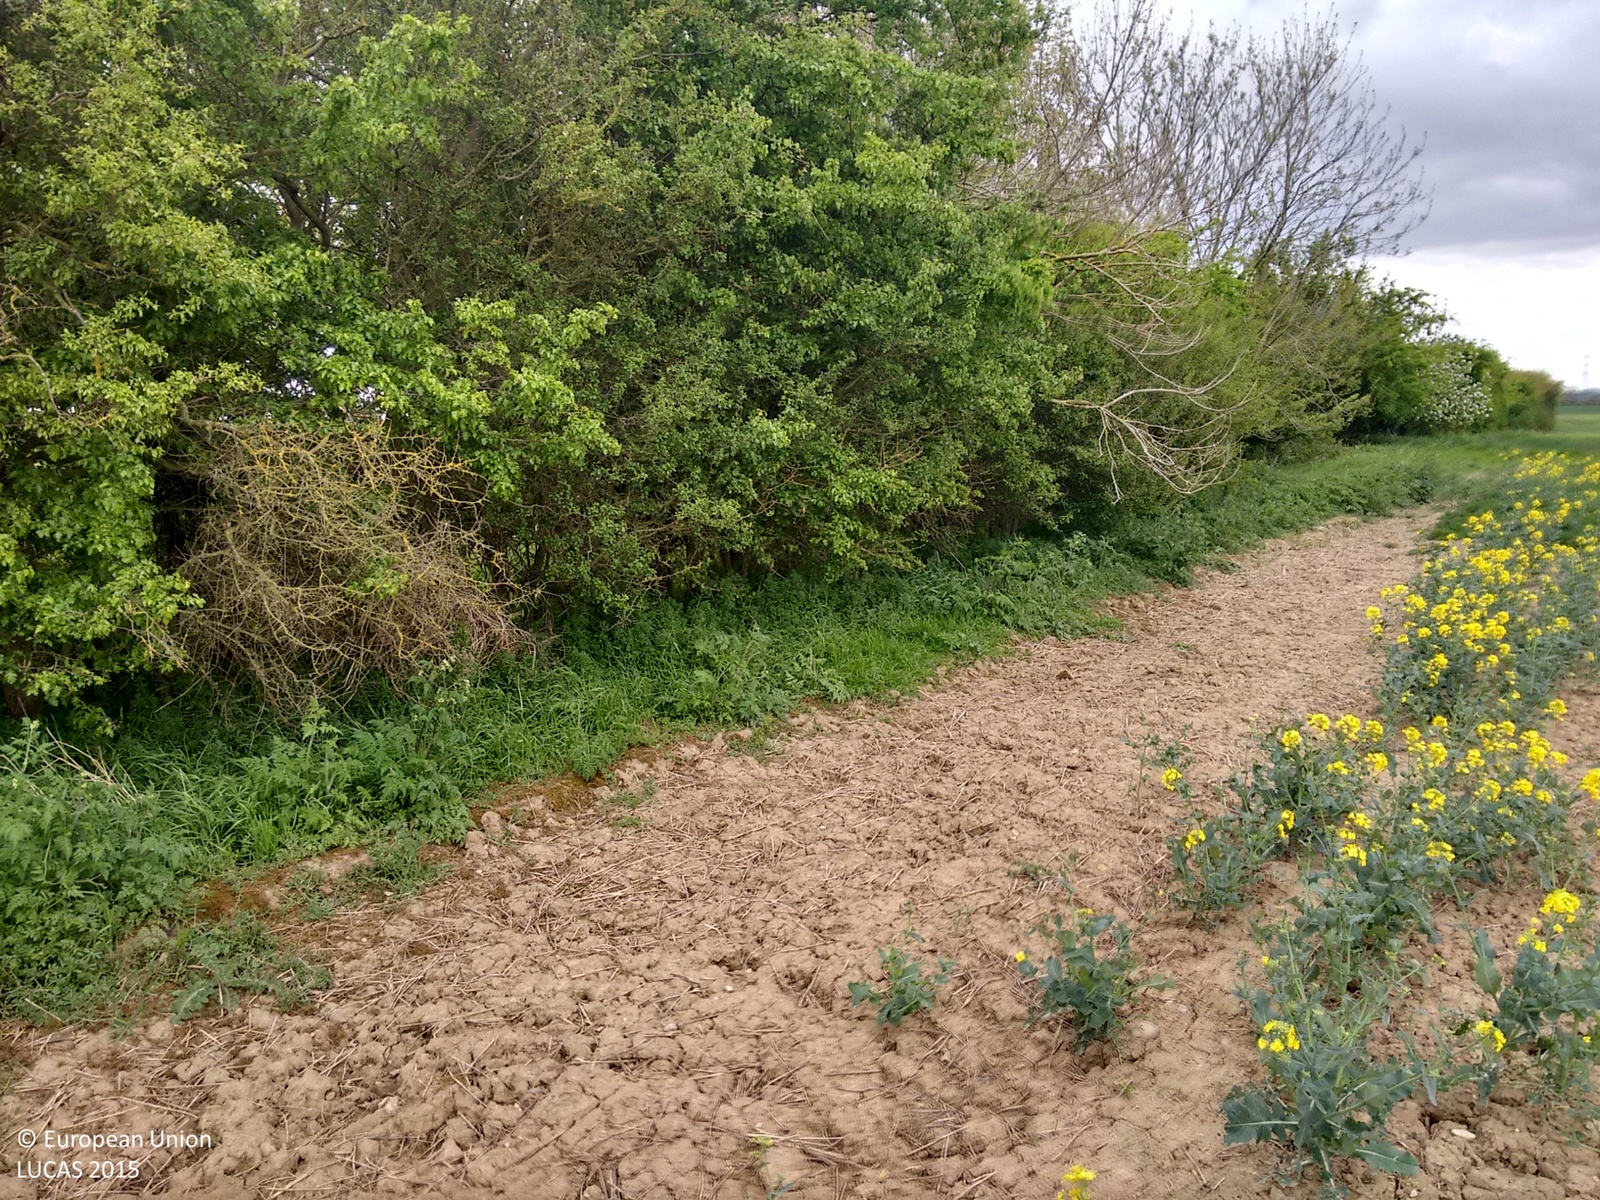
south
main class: Cropland
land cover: Rape and turnip rape
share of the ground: > 75 %
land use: Agriculture (excluding fallow land and kitchen gardens)
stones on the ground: < 10 %
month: May
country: GB
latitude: 53.8173
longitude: -0.2564
